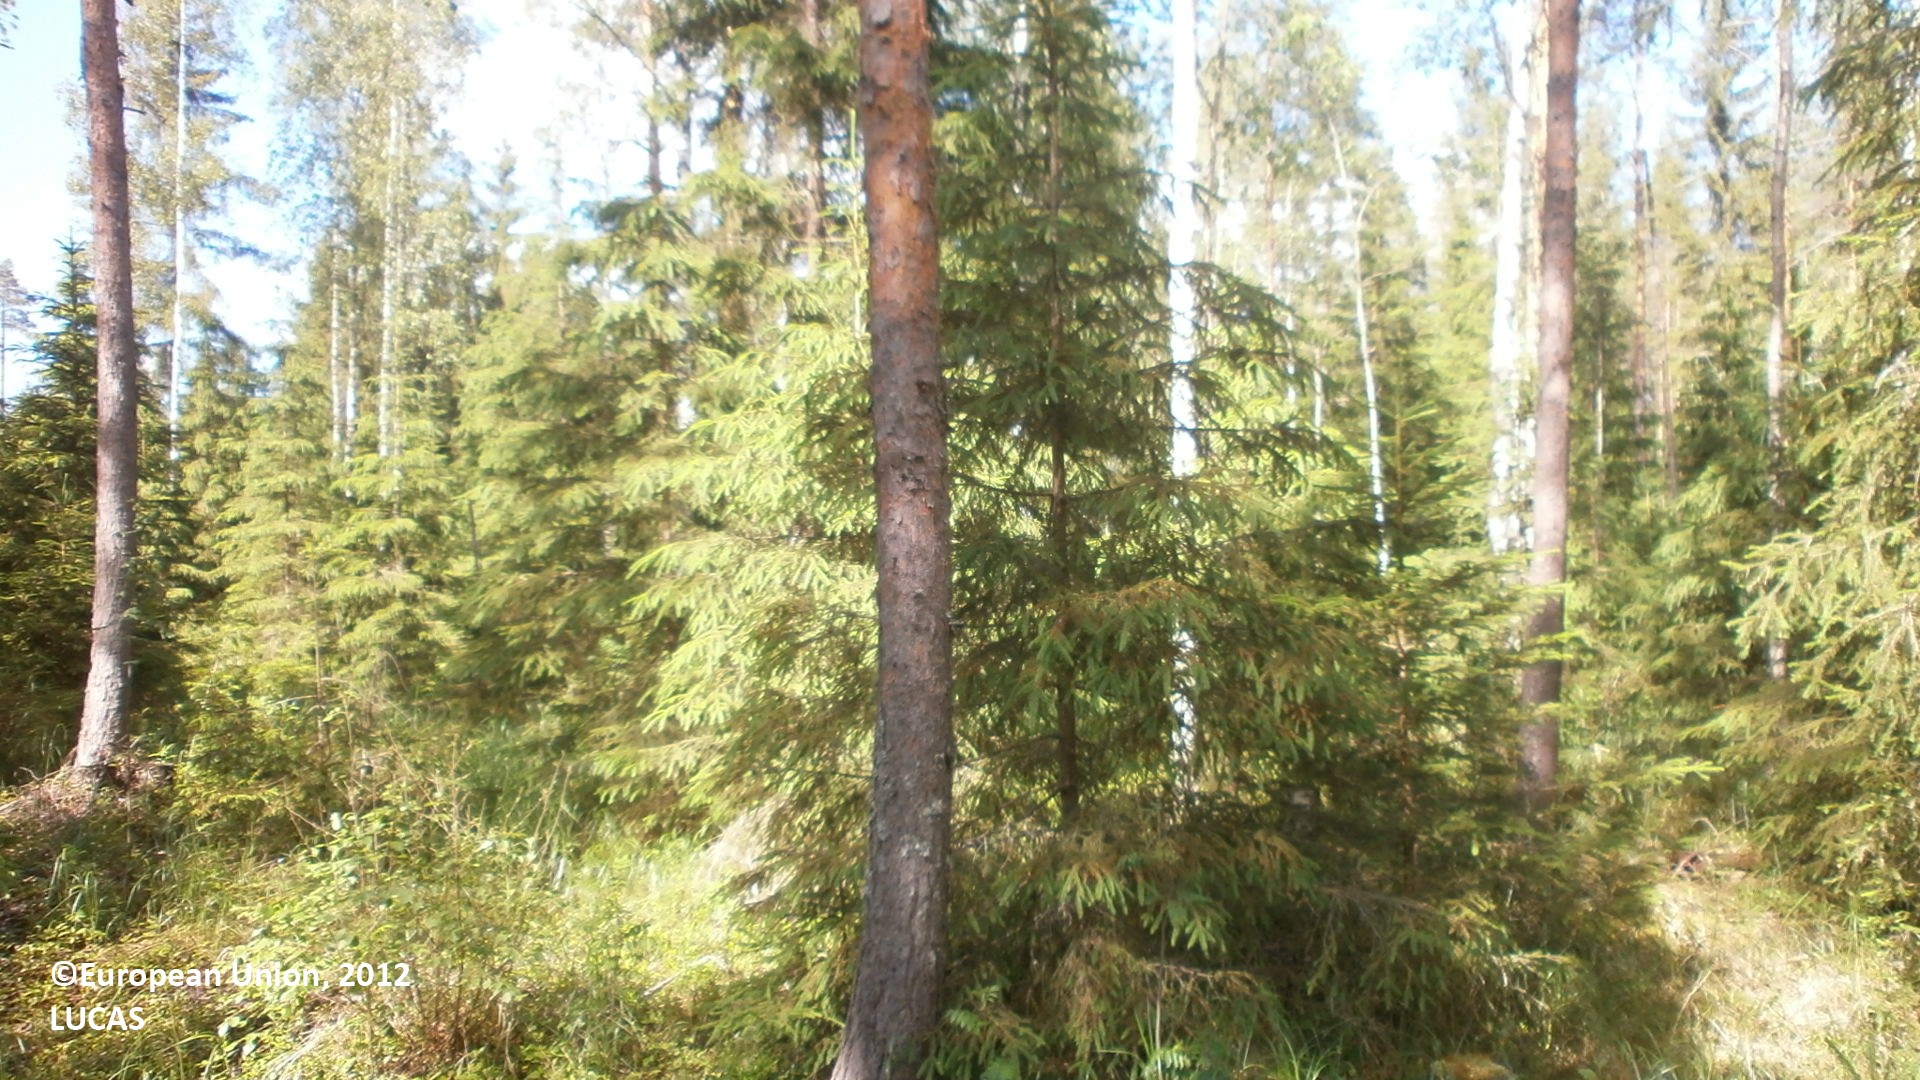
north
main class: Woodland
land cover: Pine dominated mixed woodland
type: boreal forest
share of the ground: 50 - 75 %
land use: Forestry
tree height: > 5 m
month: July
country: FI
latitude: 64.1189
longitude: 24.8435
